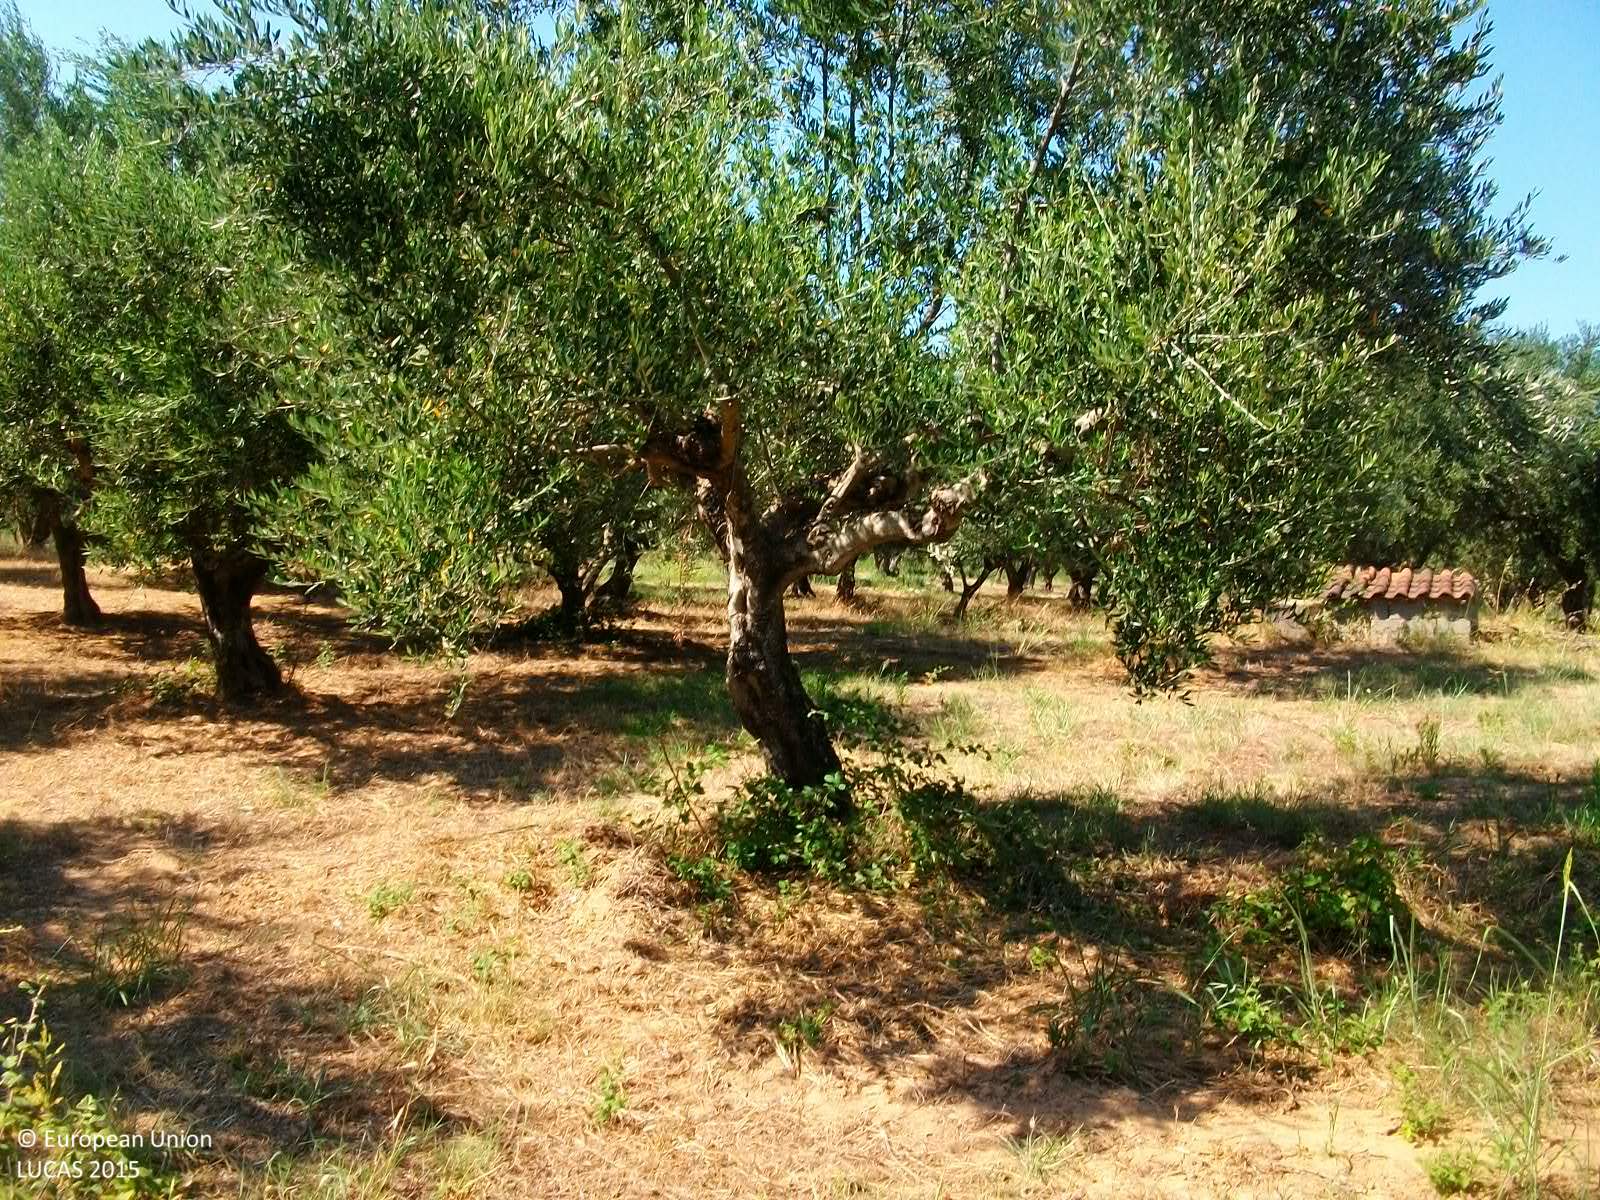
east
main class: Shrubland
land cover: Shrubland without tree cover
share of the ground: > 75 %
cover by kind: shrubs 100 %
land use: Abandoned areas
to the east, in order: Shrubland without tree cover; Olive groves; Tracks; Olive groves; Artificial constructions in urban areas; Olive groves; Fences; Olive groves; Grass margins; Tracks; Grass margins; Fences; Olive groves
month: July
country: GR
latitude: 37.0365
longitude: 21.8805
